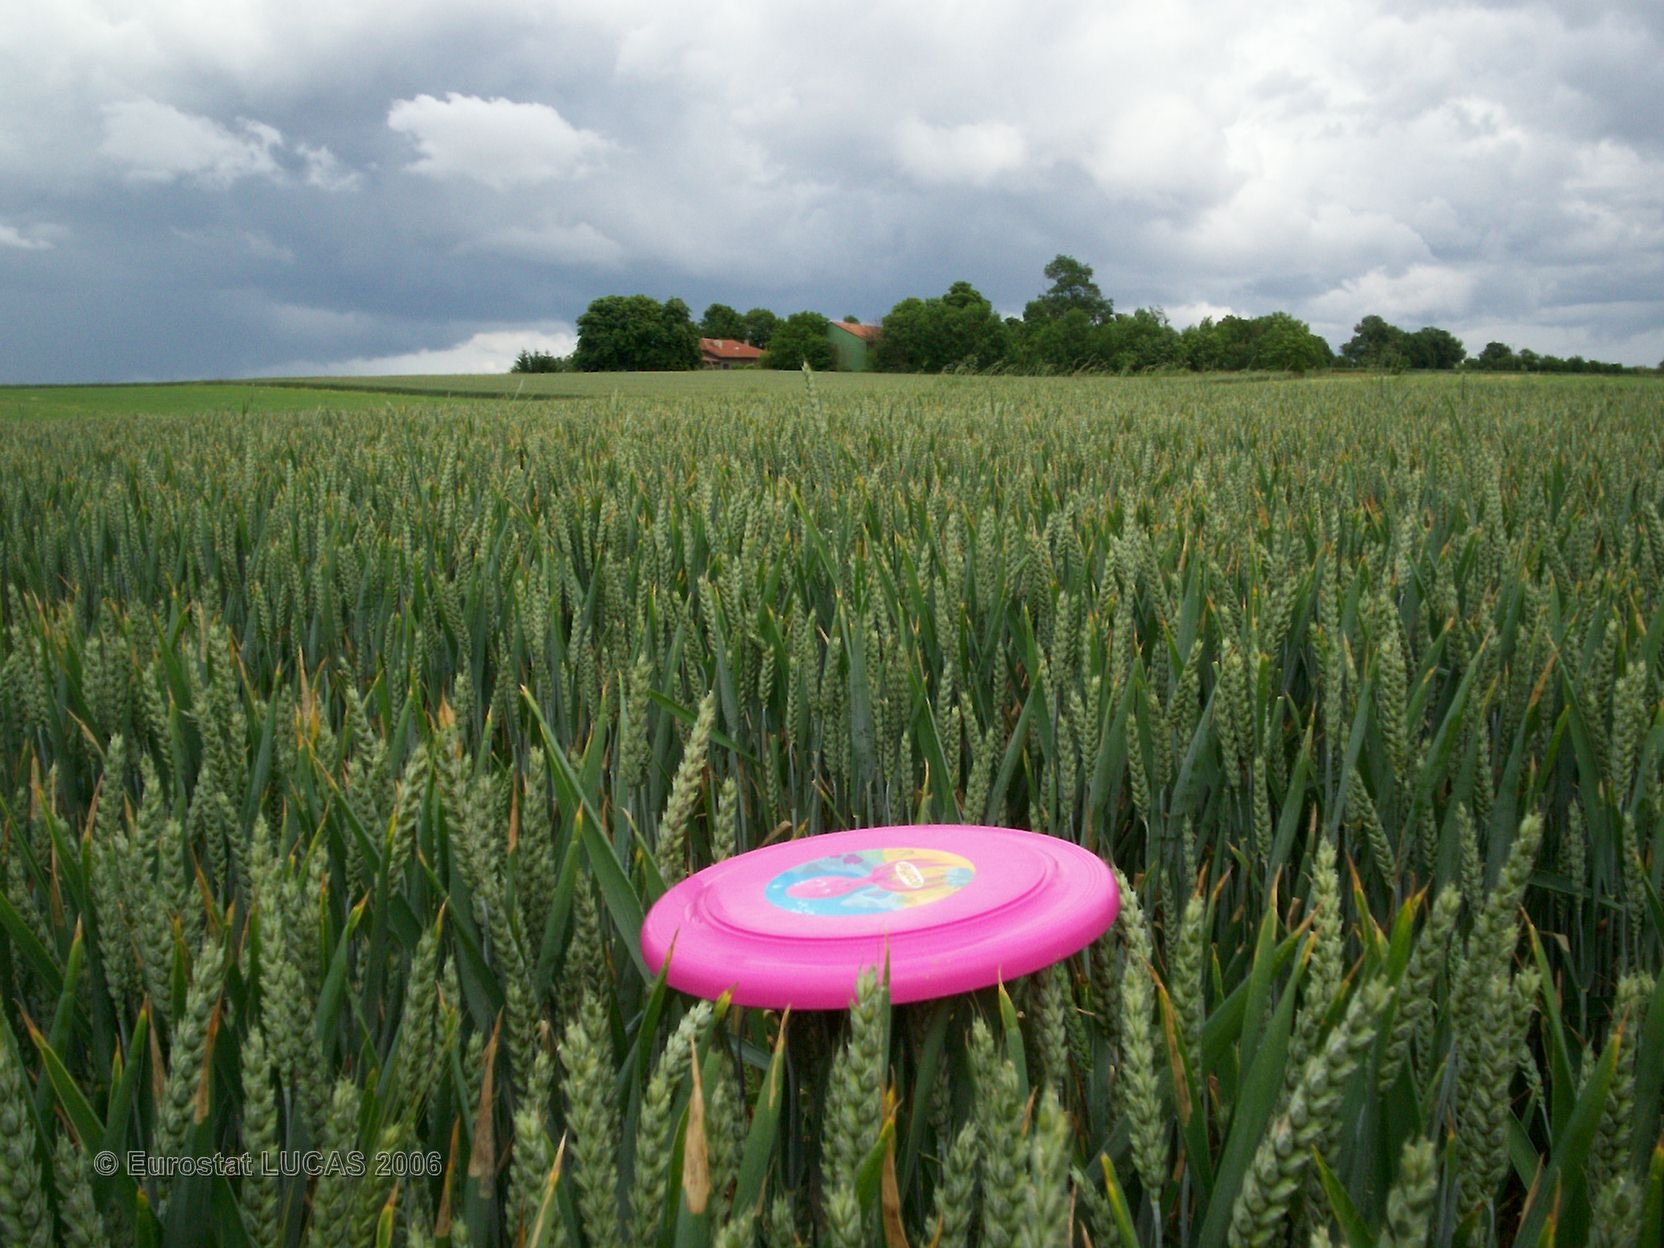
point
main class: Cropland
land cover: Common wheat
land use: Agriculture (excluding fallow land and kitchen gardens)
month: May
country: FR
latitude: 43.6113
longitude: 0.9676
